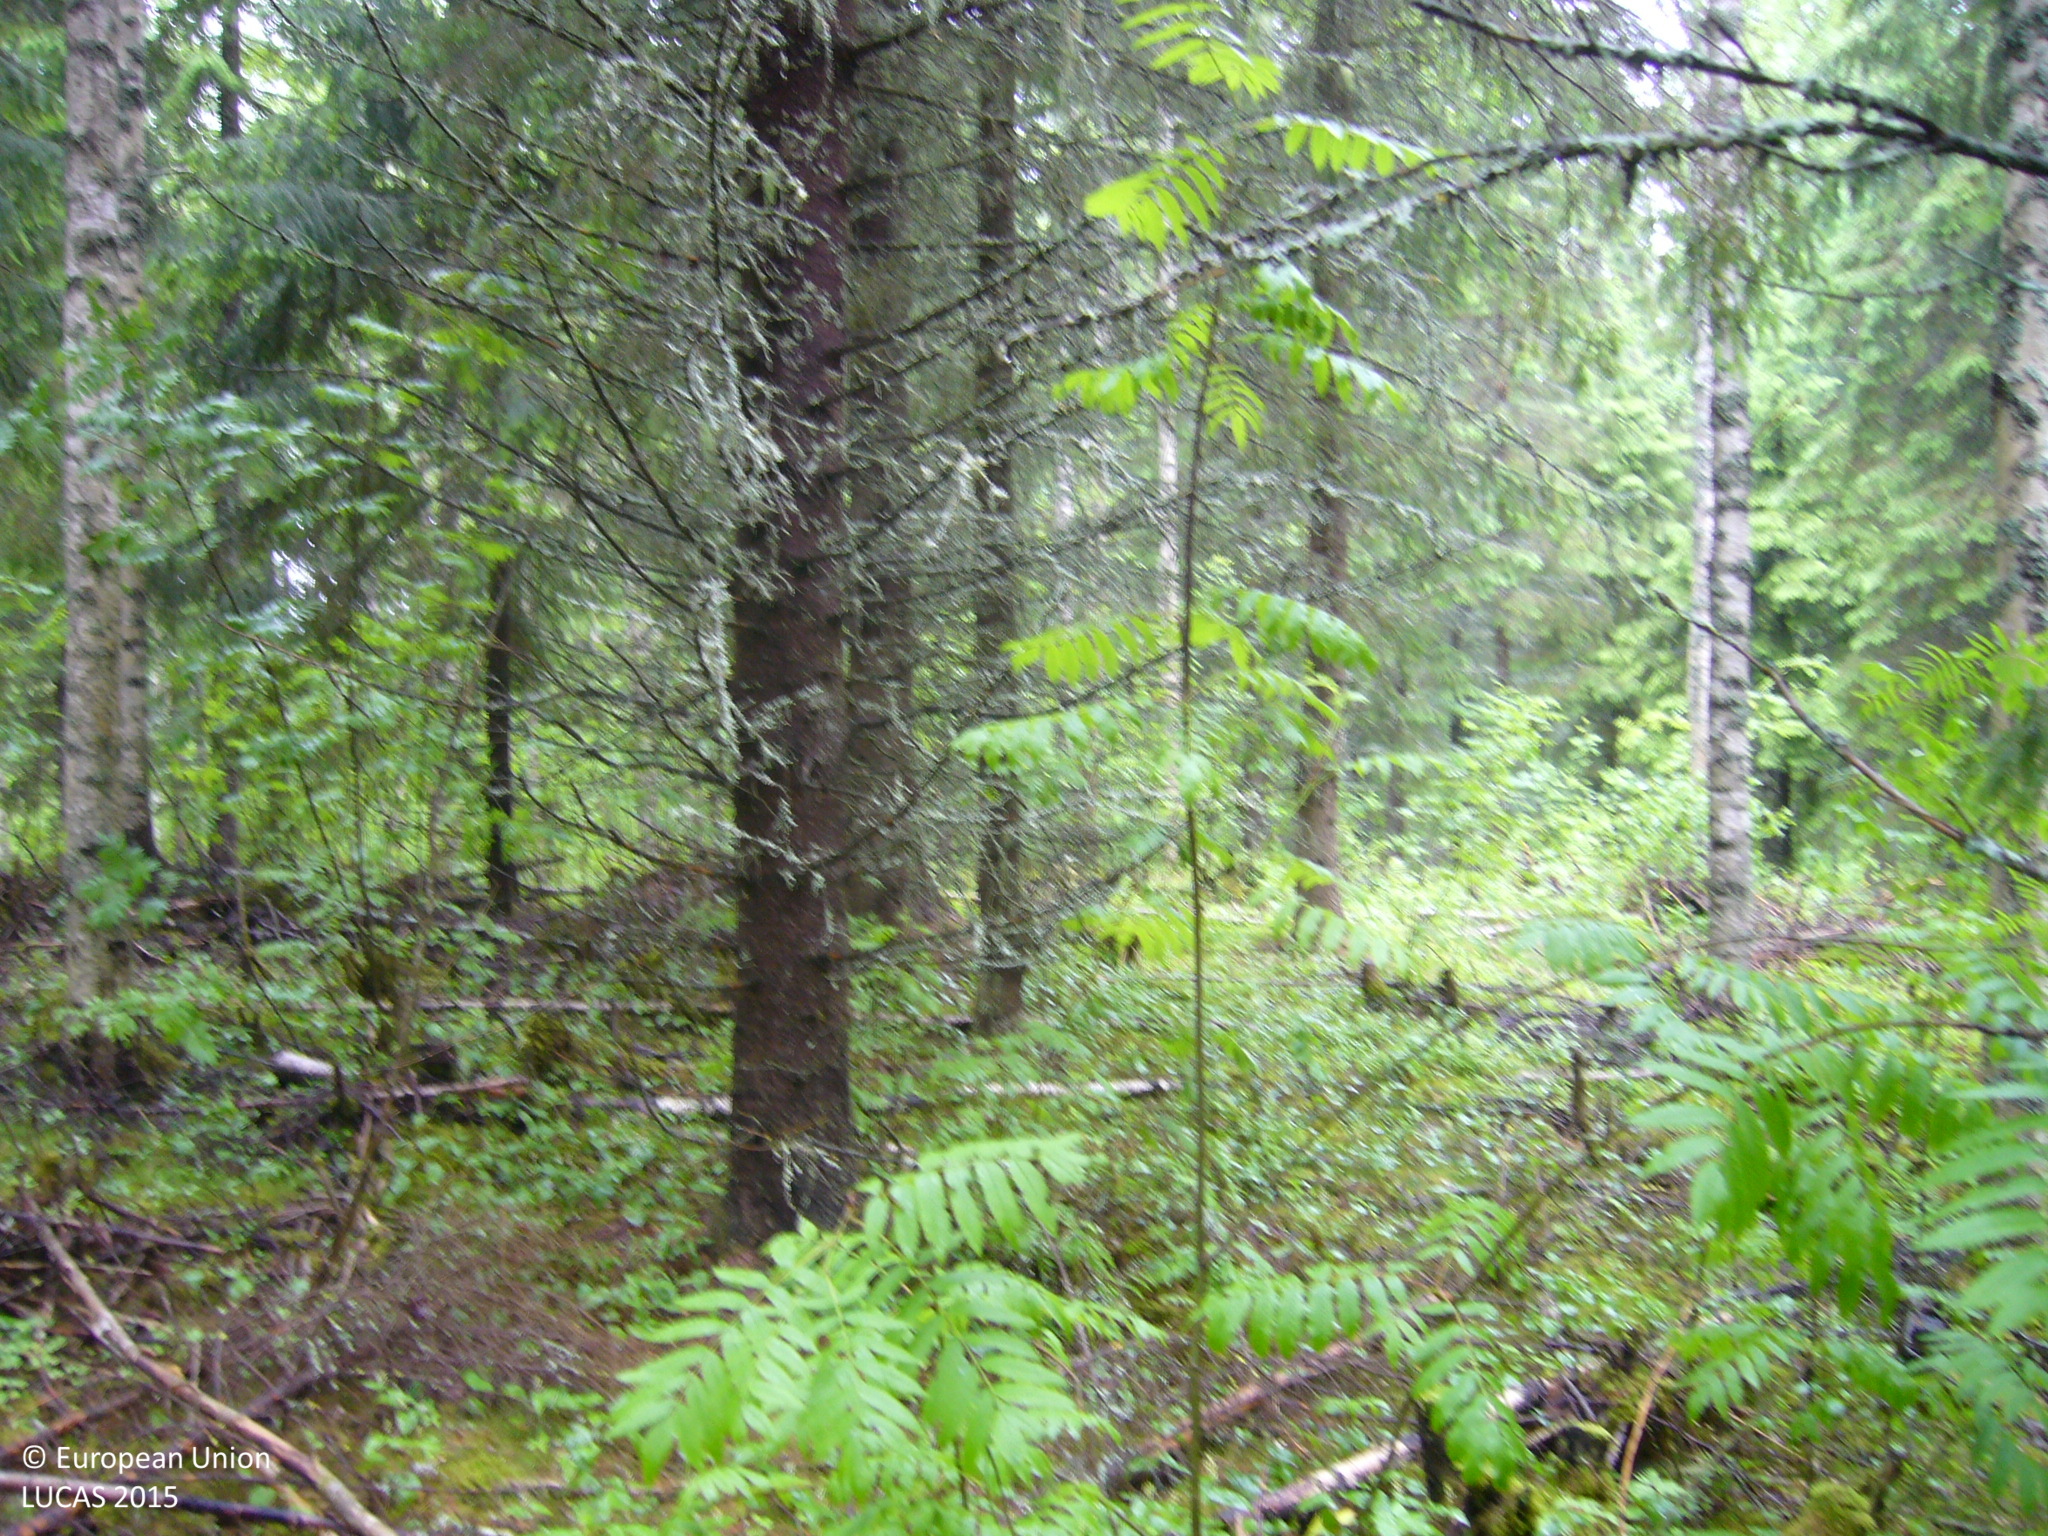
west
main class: Woodland
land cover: Spruce dominated mixed woodland
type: boreal forest
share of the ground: > 75 %
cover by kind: coniferous forest trees 55 %, broadleaved forest trees 25 %, shrubs 20 %
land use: Forestry
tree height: > 5 m
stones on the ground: < 10 %
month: June
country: FI
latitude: 63.6501
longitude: 26.5437
